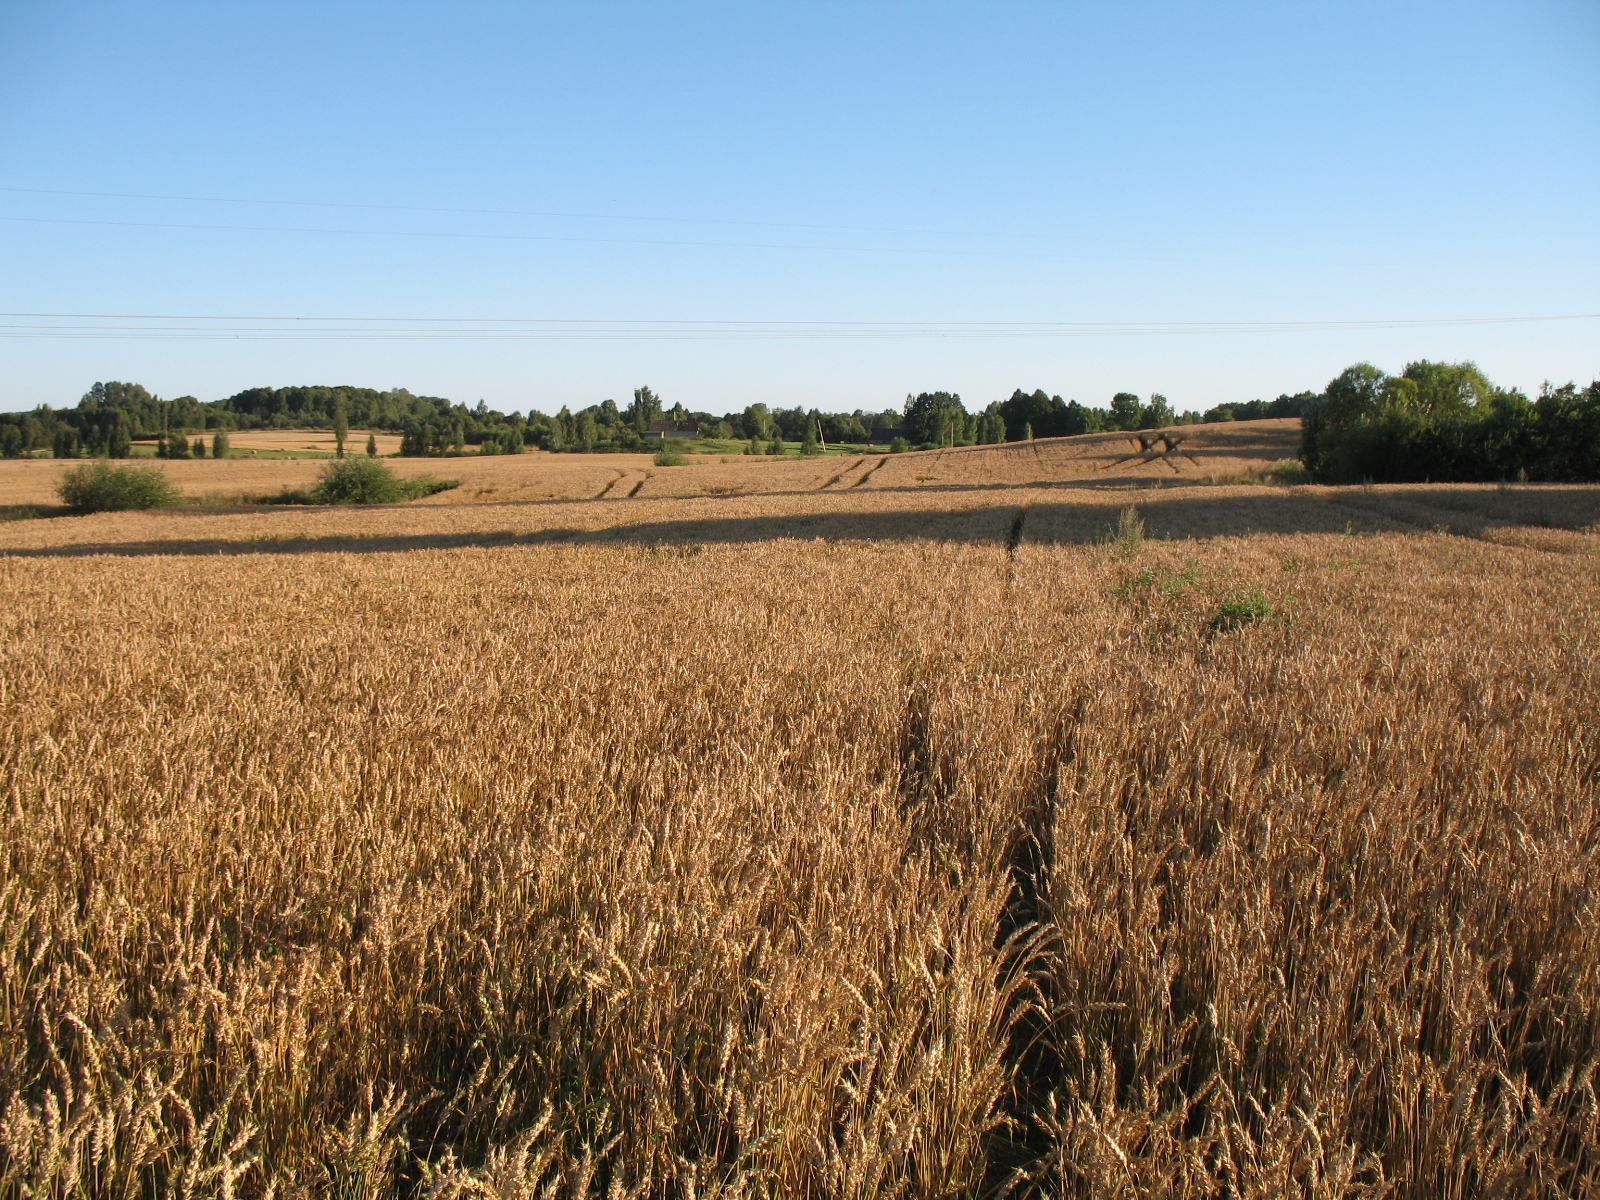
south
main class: Cropland
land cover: Common wheat
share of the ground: > 75 %
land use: Agriculture (excluding fallow land and kitchen gardens)
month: August
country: LV
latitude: 56.5653
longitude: 25.5984
